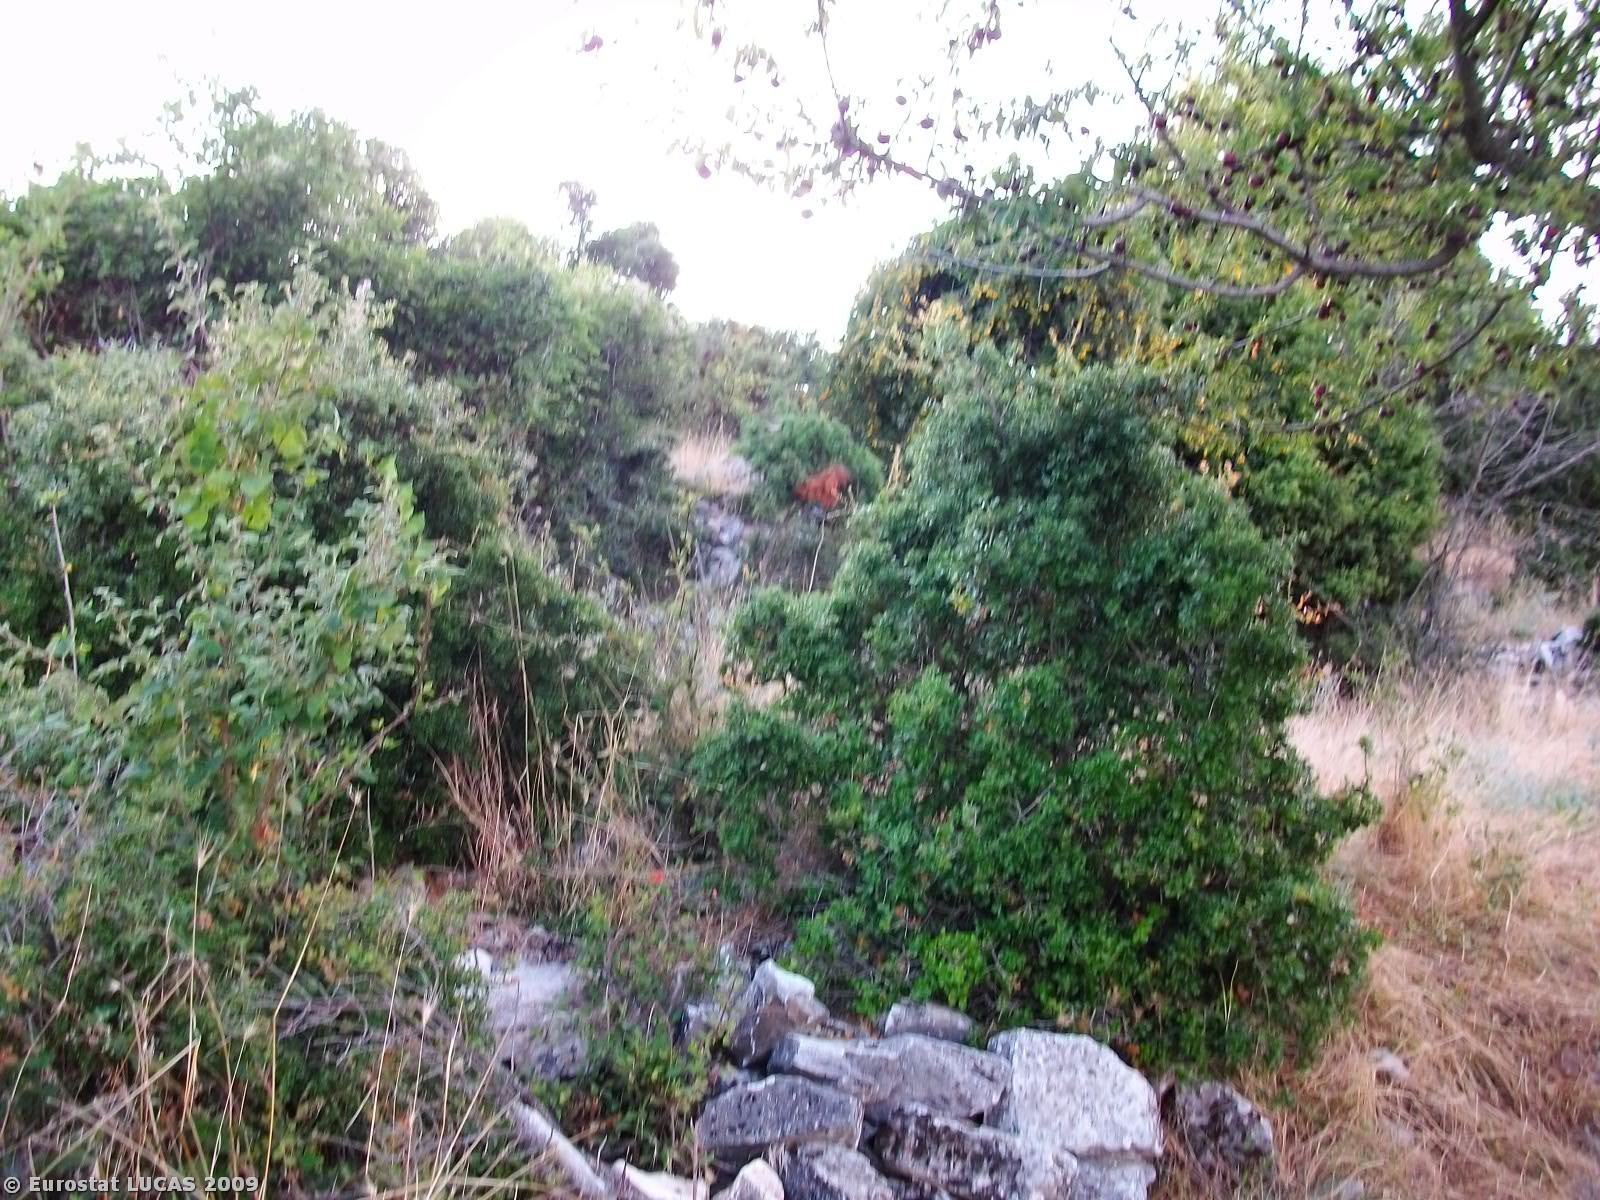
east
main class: Shrubland
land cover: Shrubland with sparse tree cover
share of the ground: 50 - 75 %
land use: Unused
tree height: < 5 m
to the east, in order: Shrubland with sparse tree cover; Grassland with sparse tree/shrub cover; Abandoned hedges; Grassland without tree/shrub cover; Grassland with sparse tree/shrub cover; Shrubland with sparse tree cover
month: July
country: GR
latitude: 41.0244
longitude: 24.5797
